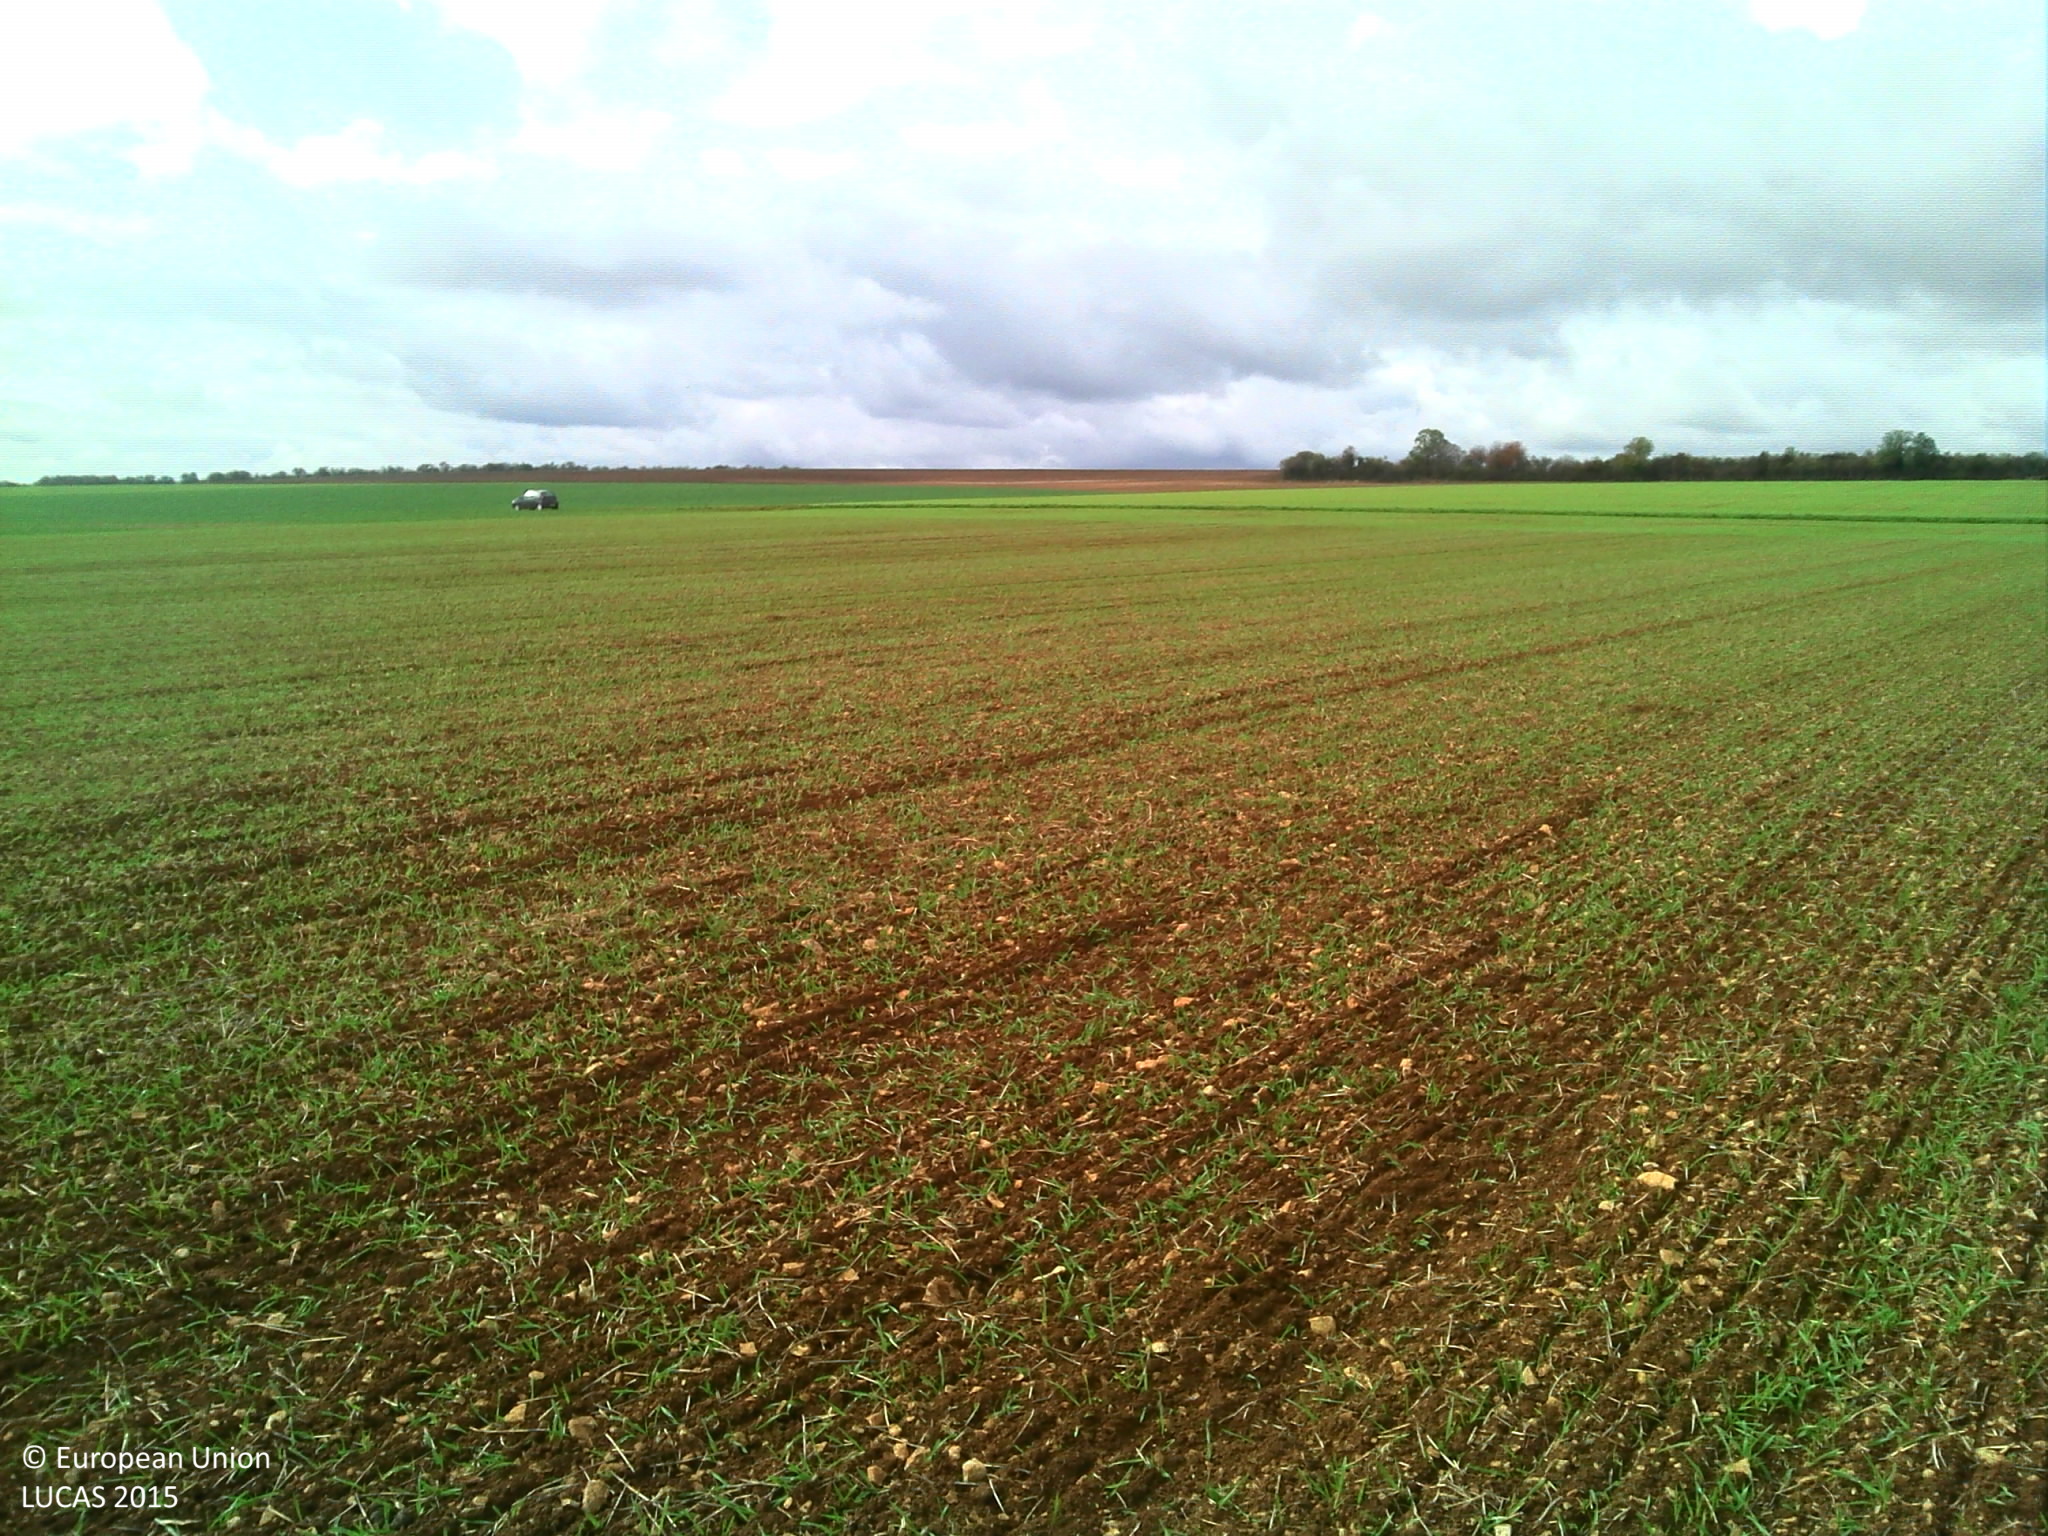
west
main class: Cropland
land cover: Common wheat
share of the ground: 25 - 50 %
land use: Agriculture (excluding fallow land and kitchen gardens)
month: October
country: FR
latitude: 47.3842
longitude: 4.9003
